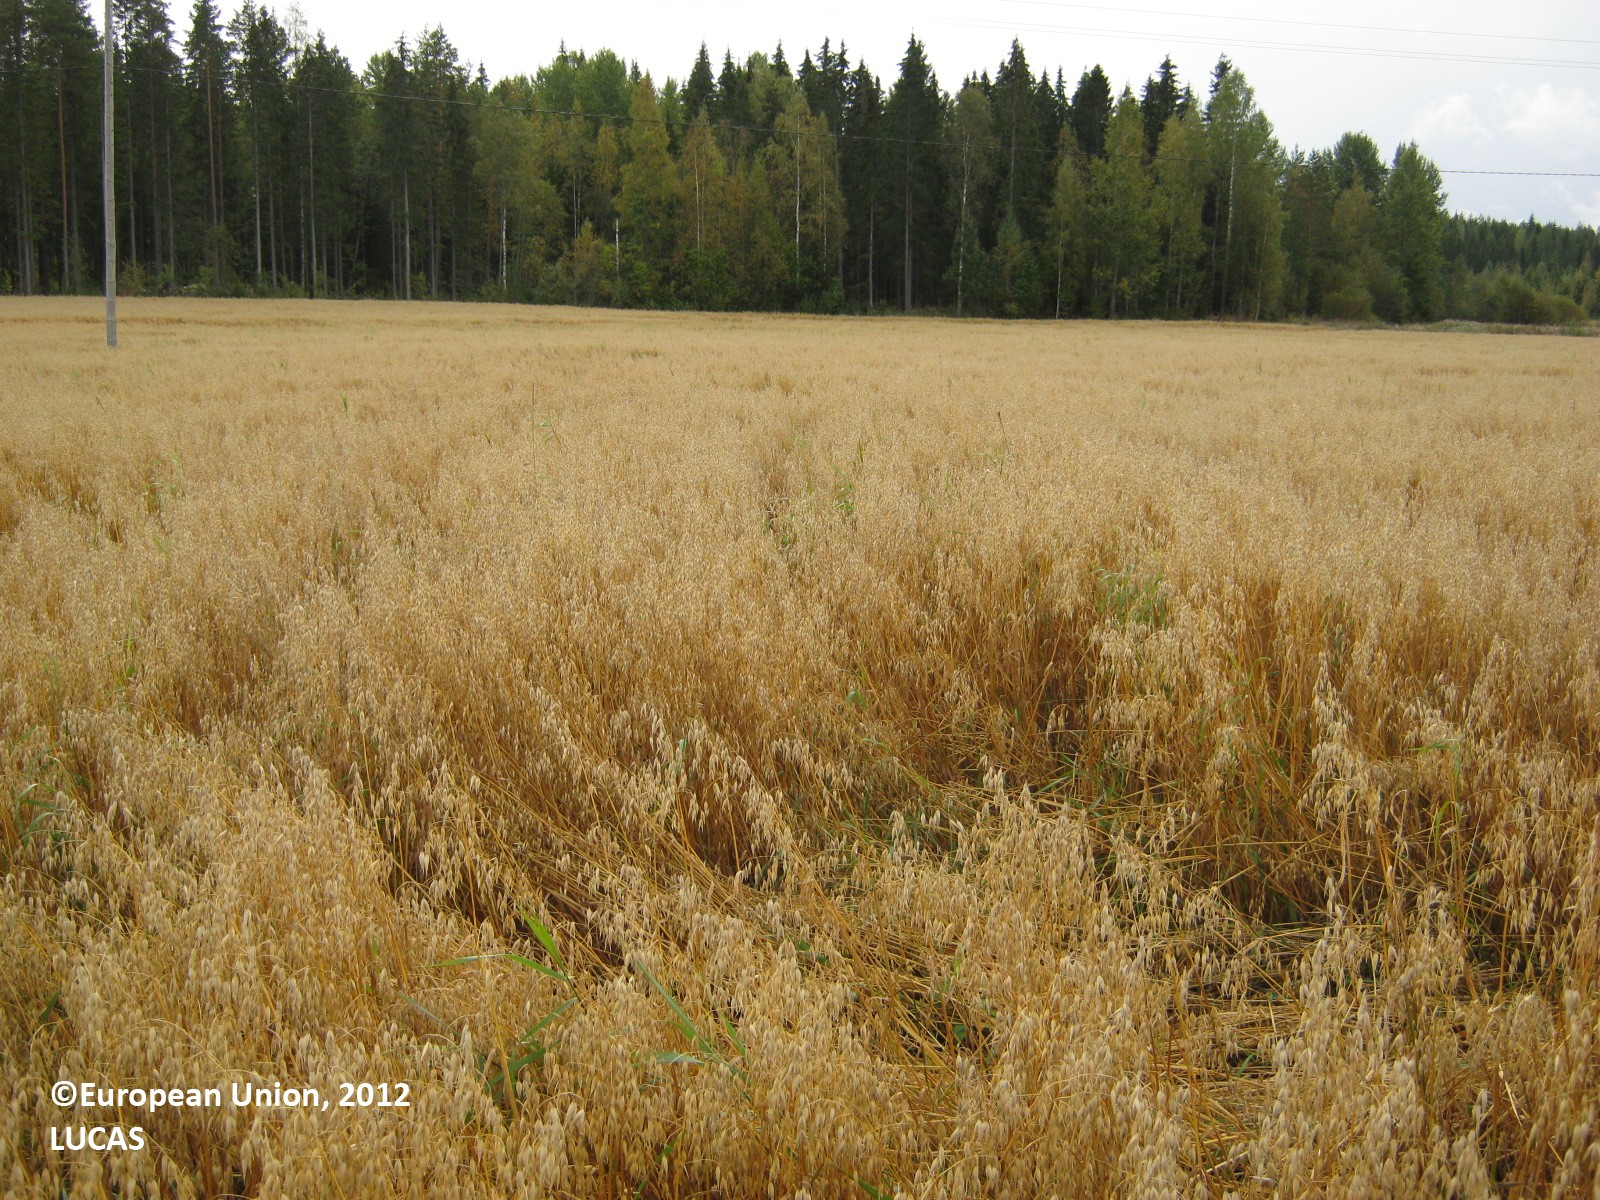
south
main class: Cropland
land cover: Oats
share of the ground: > 75 %
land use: Agriculture (excluding fallow land and kitchen gardens)
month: September
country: FI
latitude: 60.6851
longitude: 27.6389
